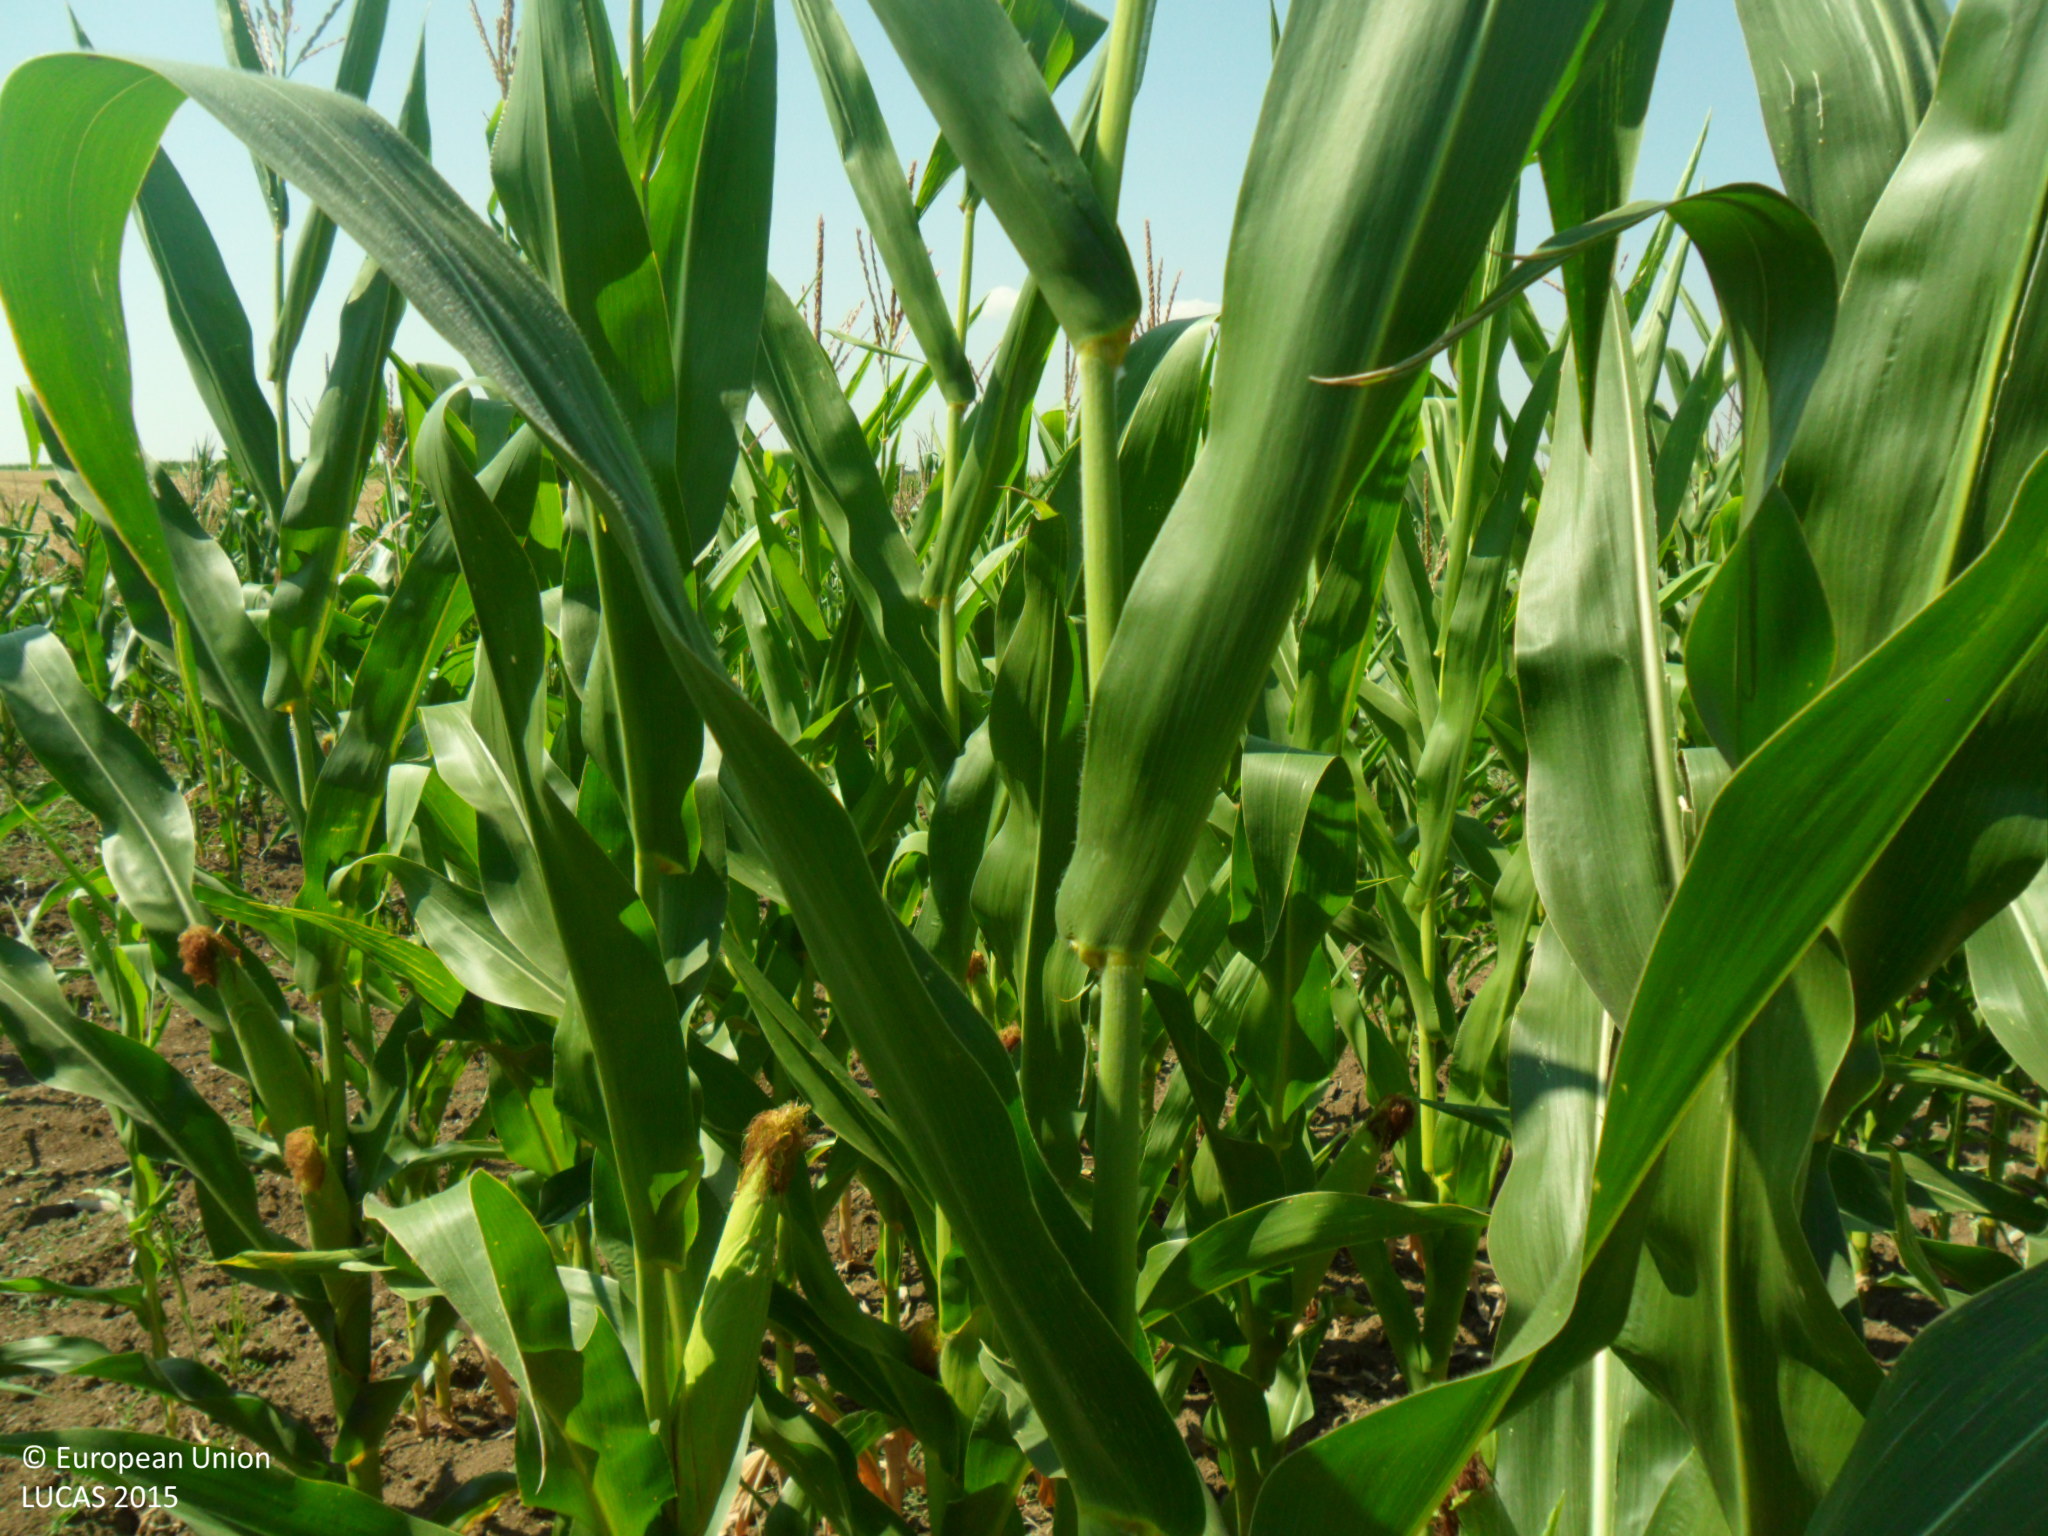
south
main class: Cropland
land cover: Maize
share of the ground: > 75 %
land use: Agriculture (excluding fallow land and kitchen gardens)
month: July
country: BG
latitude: 43.6005
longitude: 27.3092
